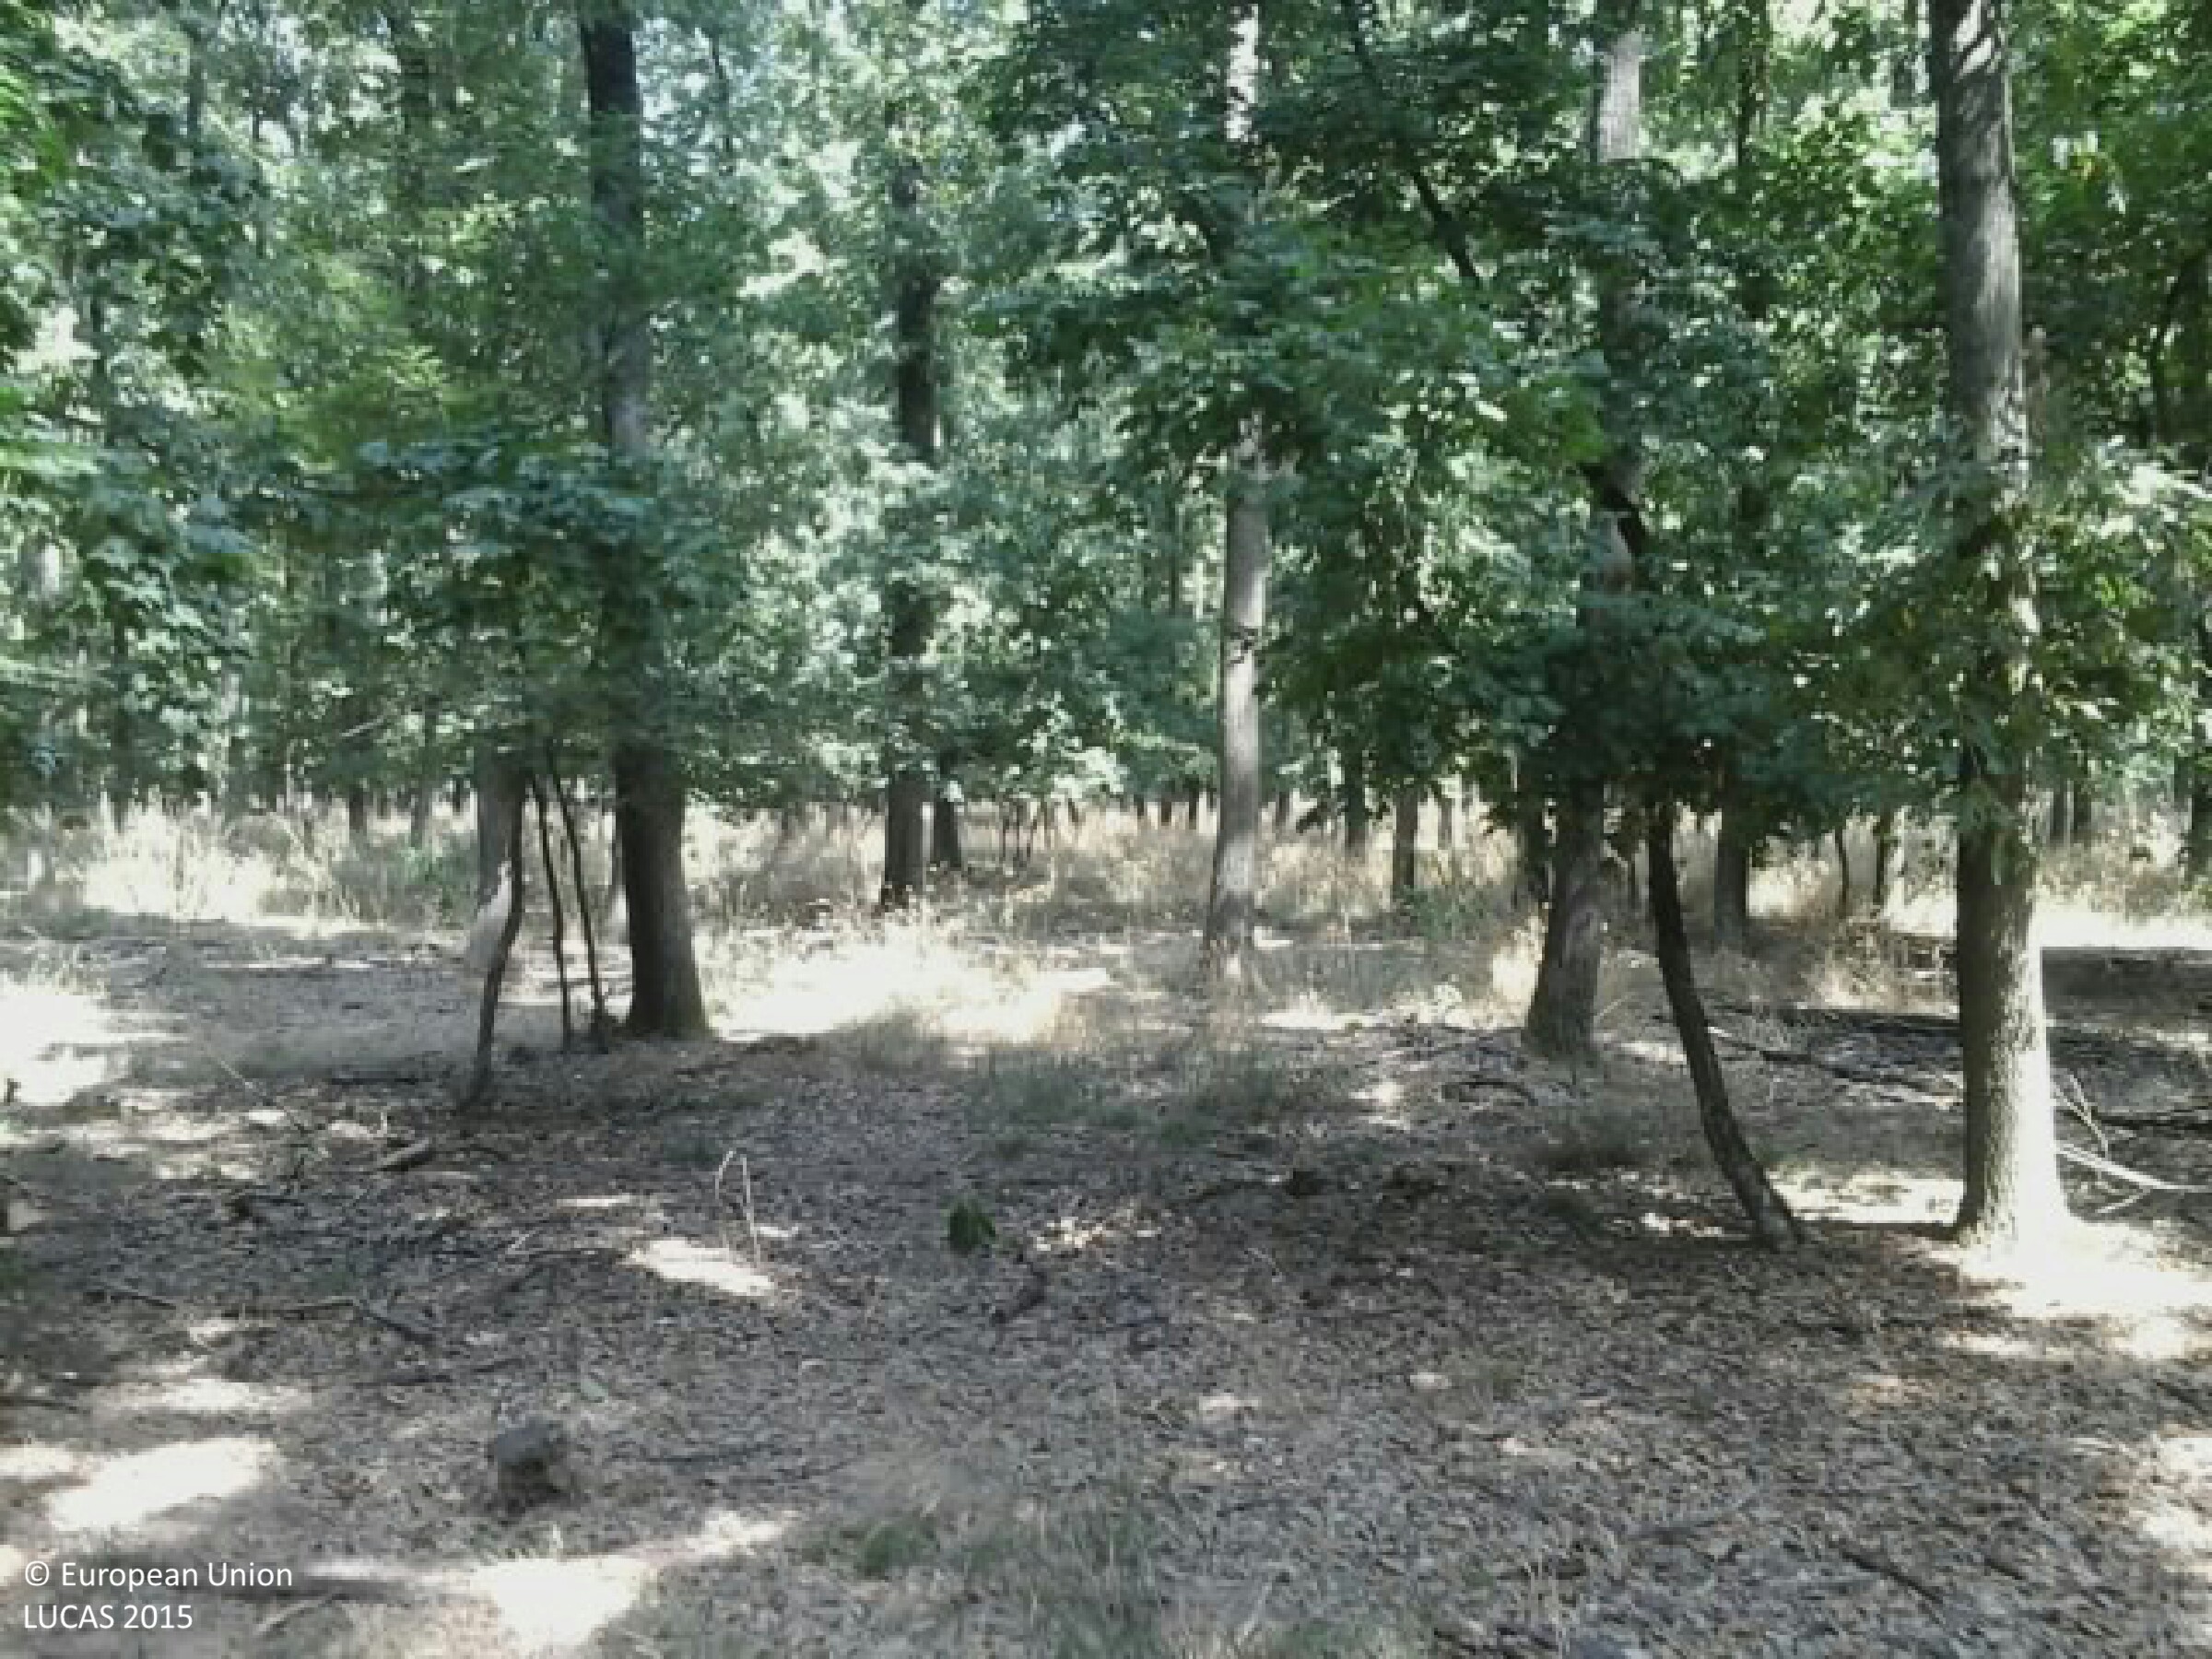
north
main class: Woodland
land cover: Broadleaved woodland
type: mesophytic deciduous forest
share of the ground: > 75 %
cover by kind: broadleaved forest trees 95 %, herbaceous plants 5 %
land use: Forestry
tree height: < 5 m
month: August
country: HU
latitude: 46.5618
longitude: 18.1879
